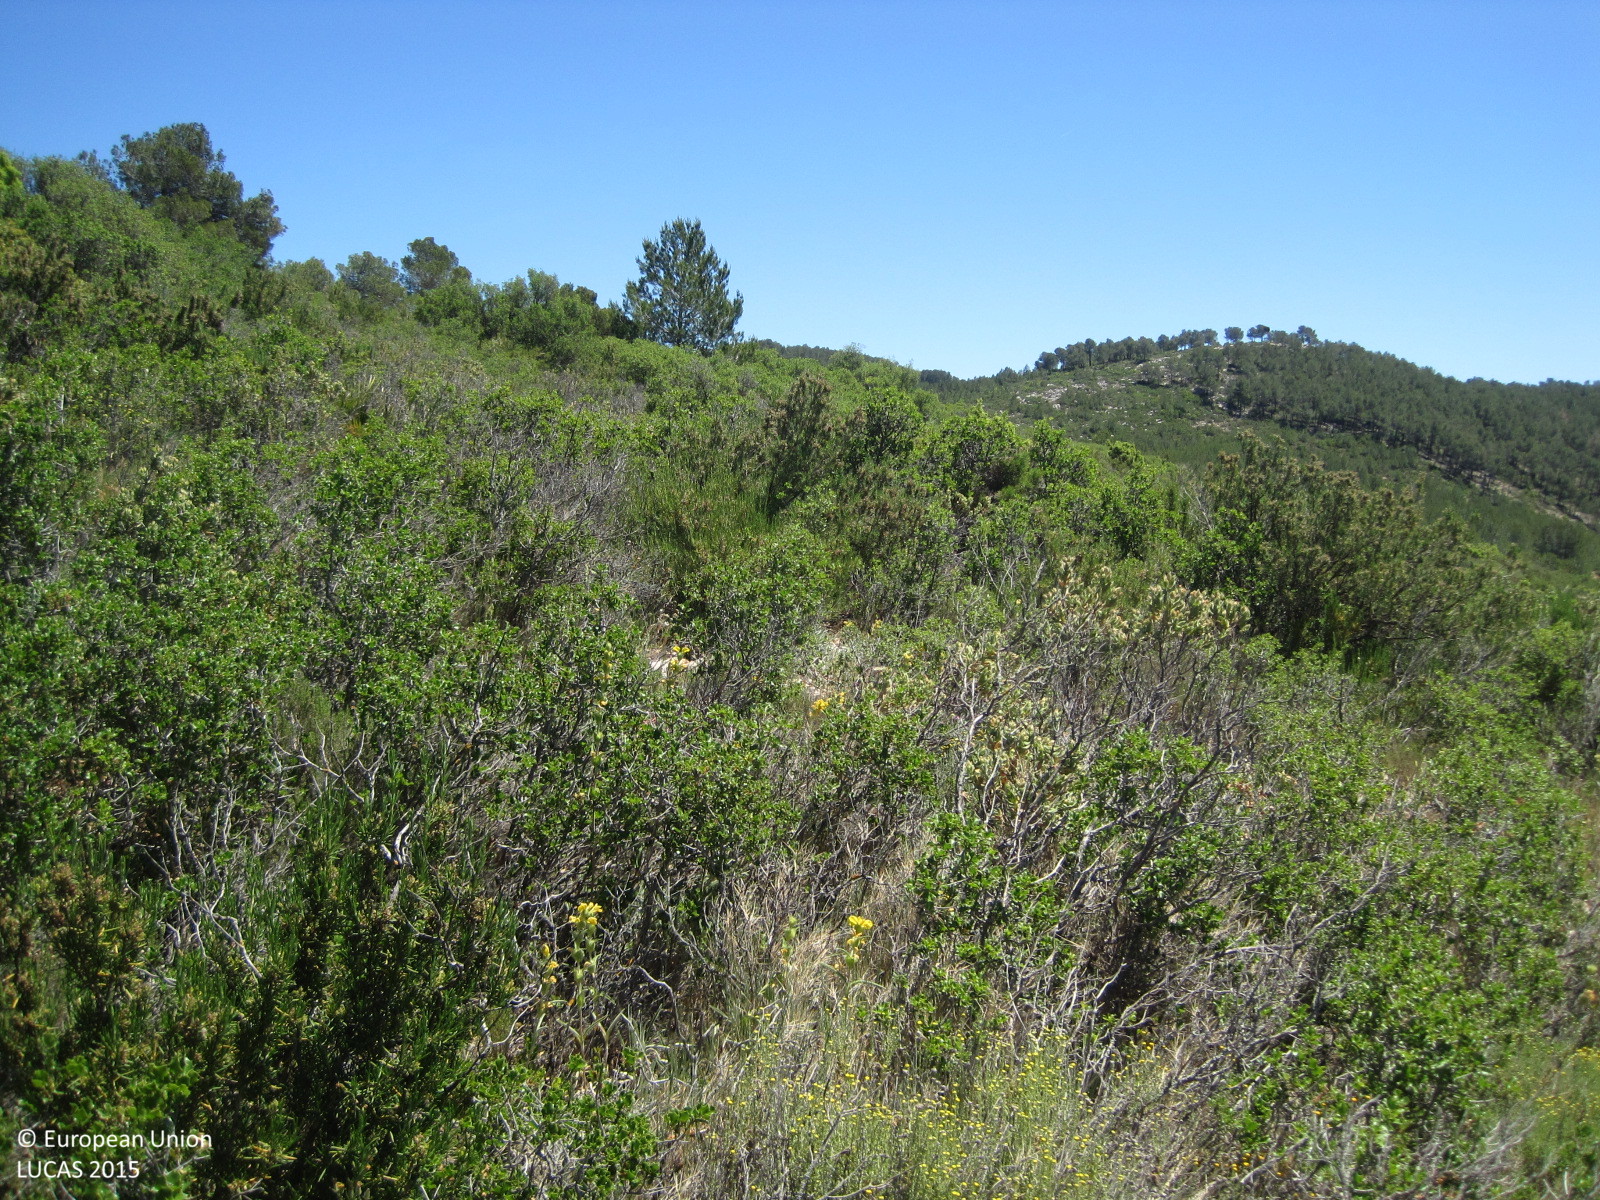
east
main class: Shrubland
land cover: Shrubland without tree cover
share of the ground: > 75 %
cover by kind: shrubs 95 %, consolidated bare surface 5 %
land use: Semi-natural and natural areas not in use
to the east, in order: Shrubland without tree cover; Nuts trees; Pine dominated coniferous woodland; Barley; Pine dominated coniferous woodland; Barley; Pine dominated coniferous woodland
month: May
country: ES
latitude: 39.4254
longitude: -0.8607
